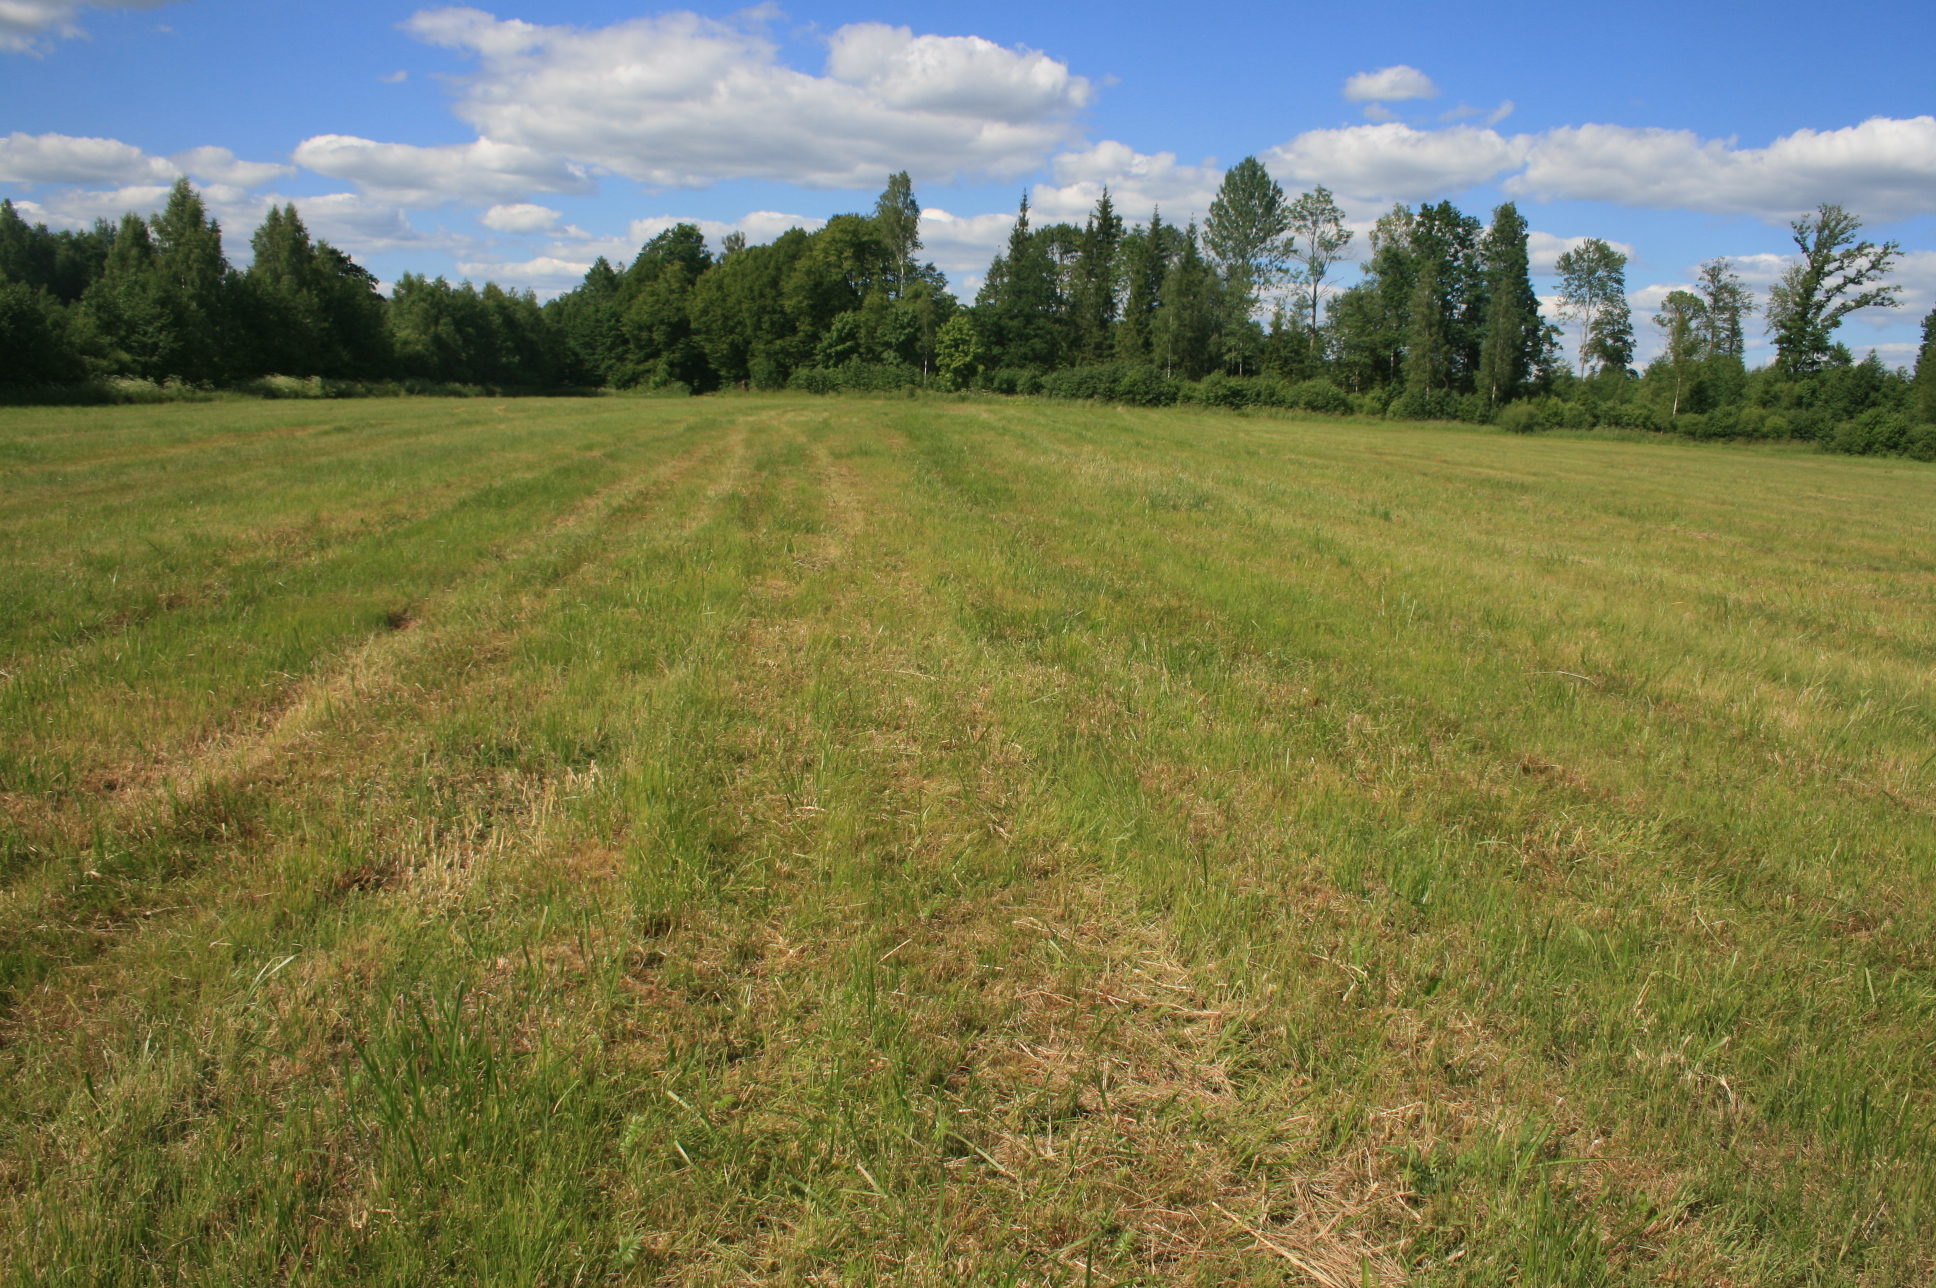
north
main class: Grassland
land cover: Grassland without tree/shrub cover
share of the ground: > 75 %
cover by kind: herbaceous plants 95 %, lichens and mosses 5 %
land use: Agriculture (excluding fallow land and kitchen gardens)
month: June
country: LT
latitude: 55.4087
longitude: 22.1380
